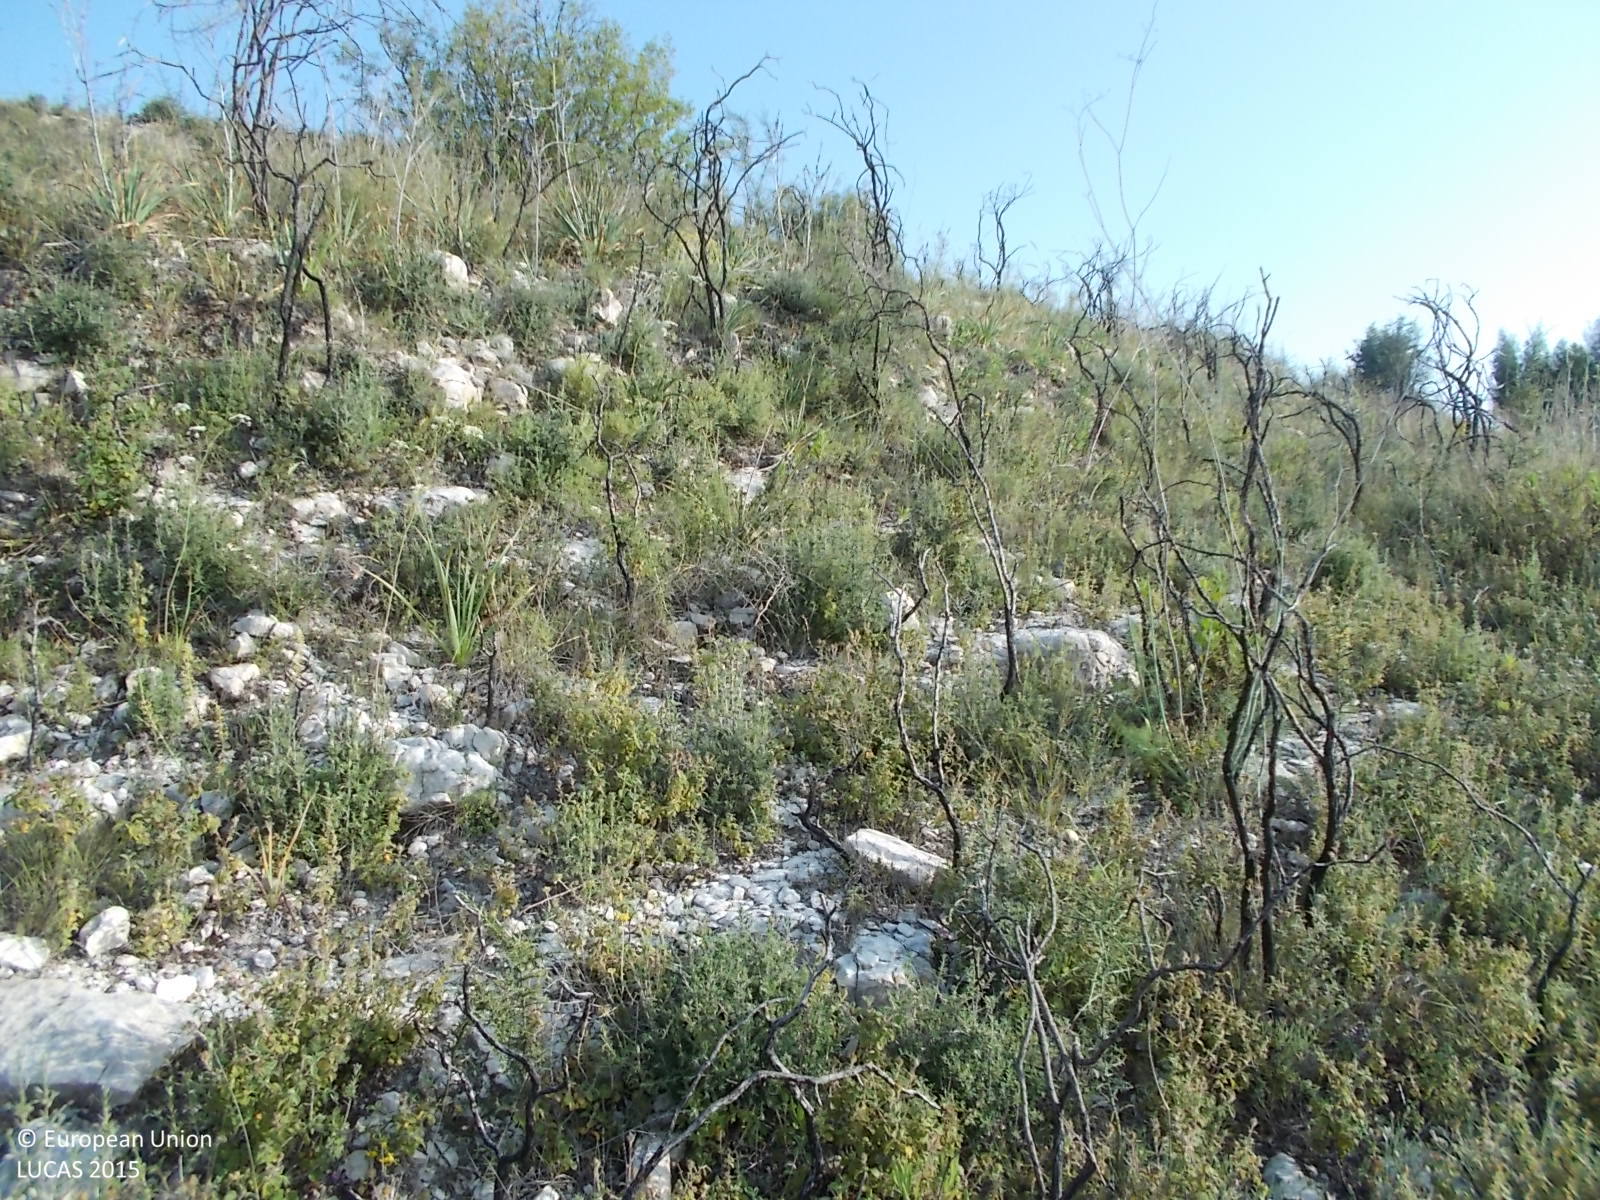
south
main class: Cropland
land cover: Vineyards
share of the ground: 25 - 50 %
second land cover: Other bare soil
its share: > 75 %
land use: Agriculture (excluding fallow land and kitchen gardens)
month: May
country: CY
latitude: 34.9082
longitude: 32.3984
